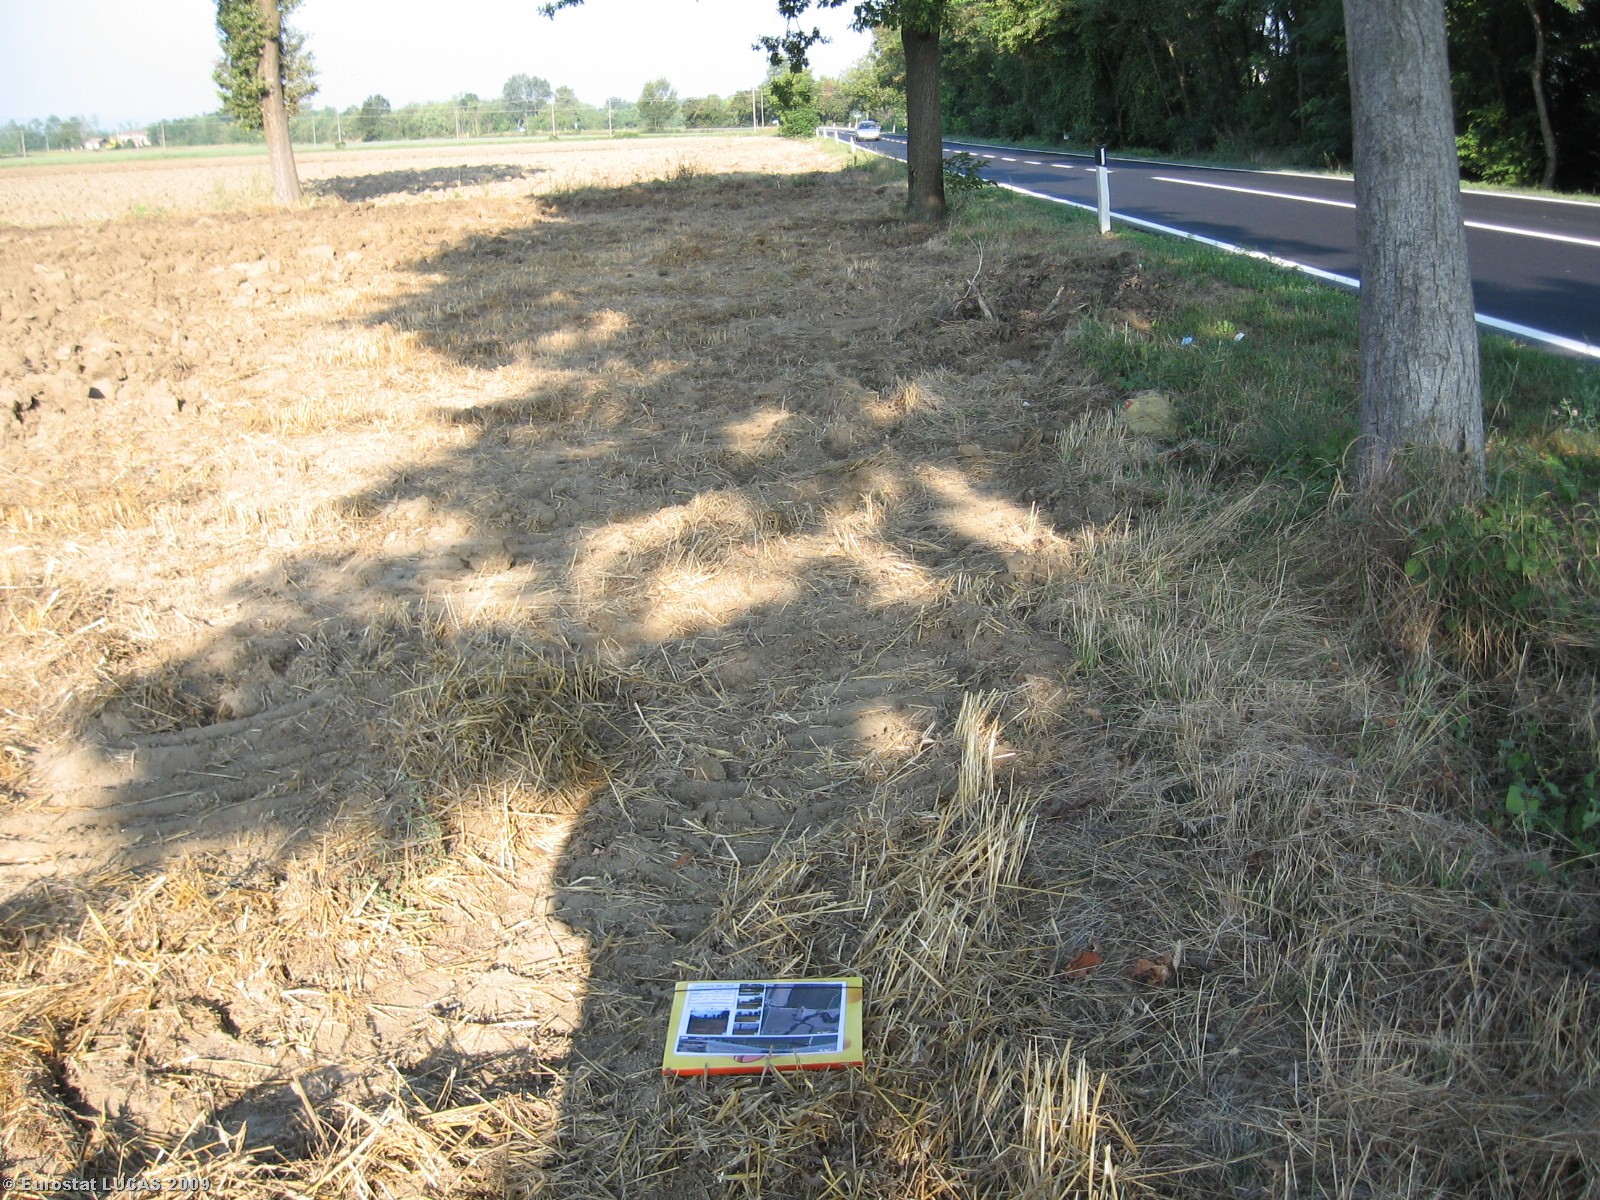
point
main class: Cropland
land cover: Common wheat
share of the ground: < 10 %
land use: Agriculture (excluding fallow land and kitchen gardens)
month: August
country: IT
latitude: 45.0167
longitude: 9.5314
